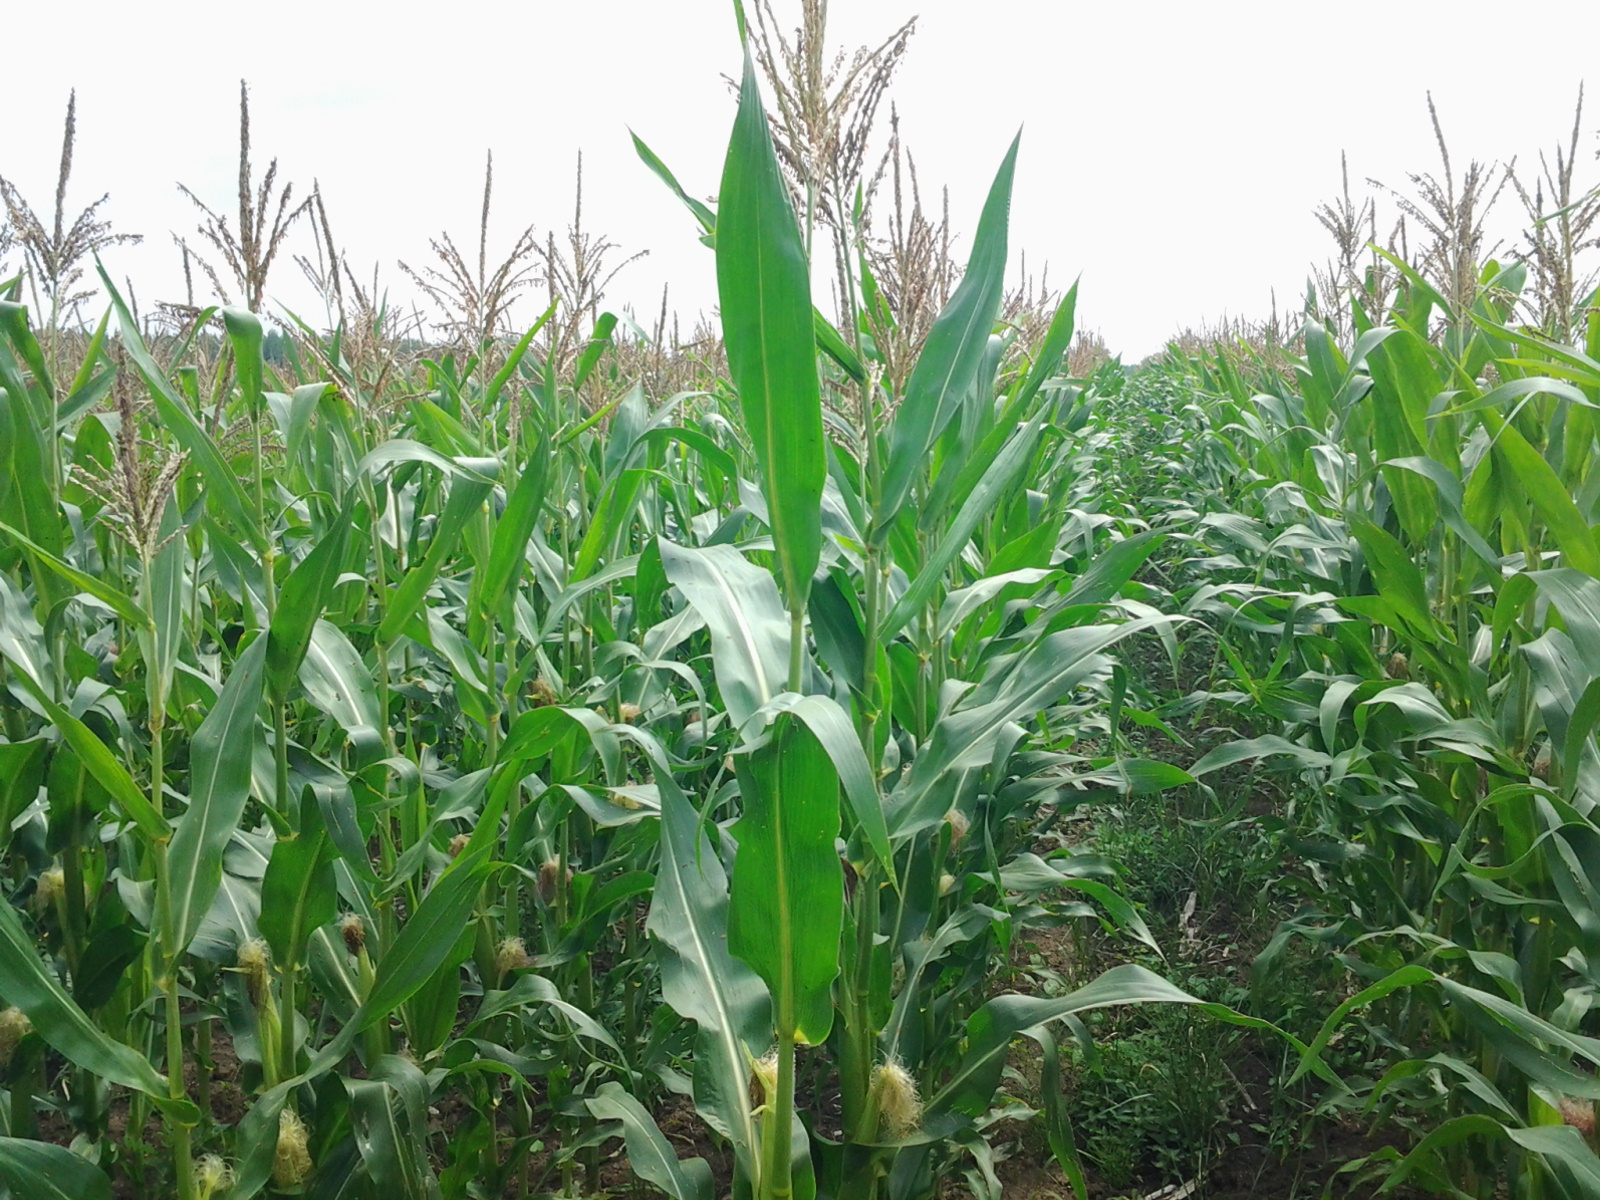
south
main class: Cropland
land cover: Maize
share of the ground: > 75 %
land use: Agriculture (excluding fallow land and kitchen gardens)
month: June
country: HU
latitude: 47.1180
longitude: 20.1615
